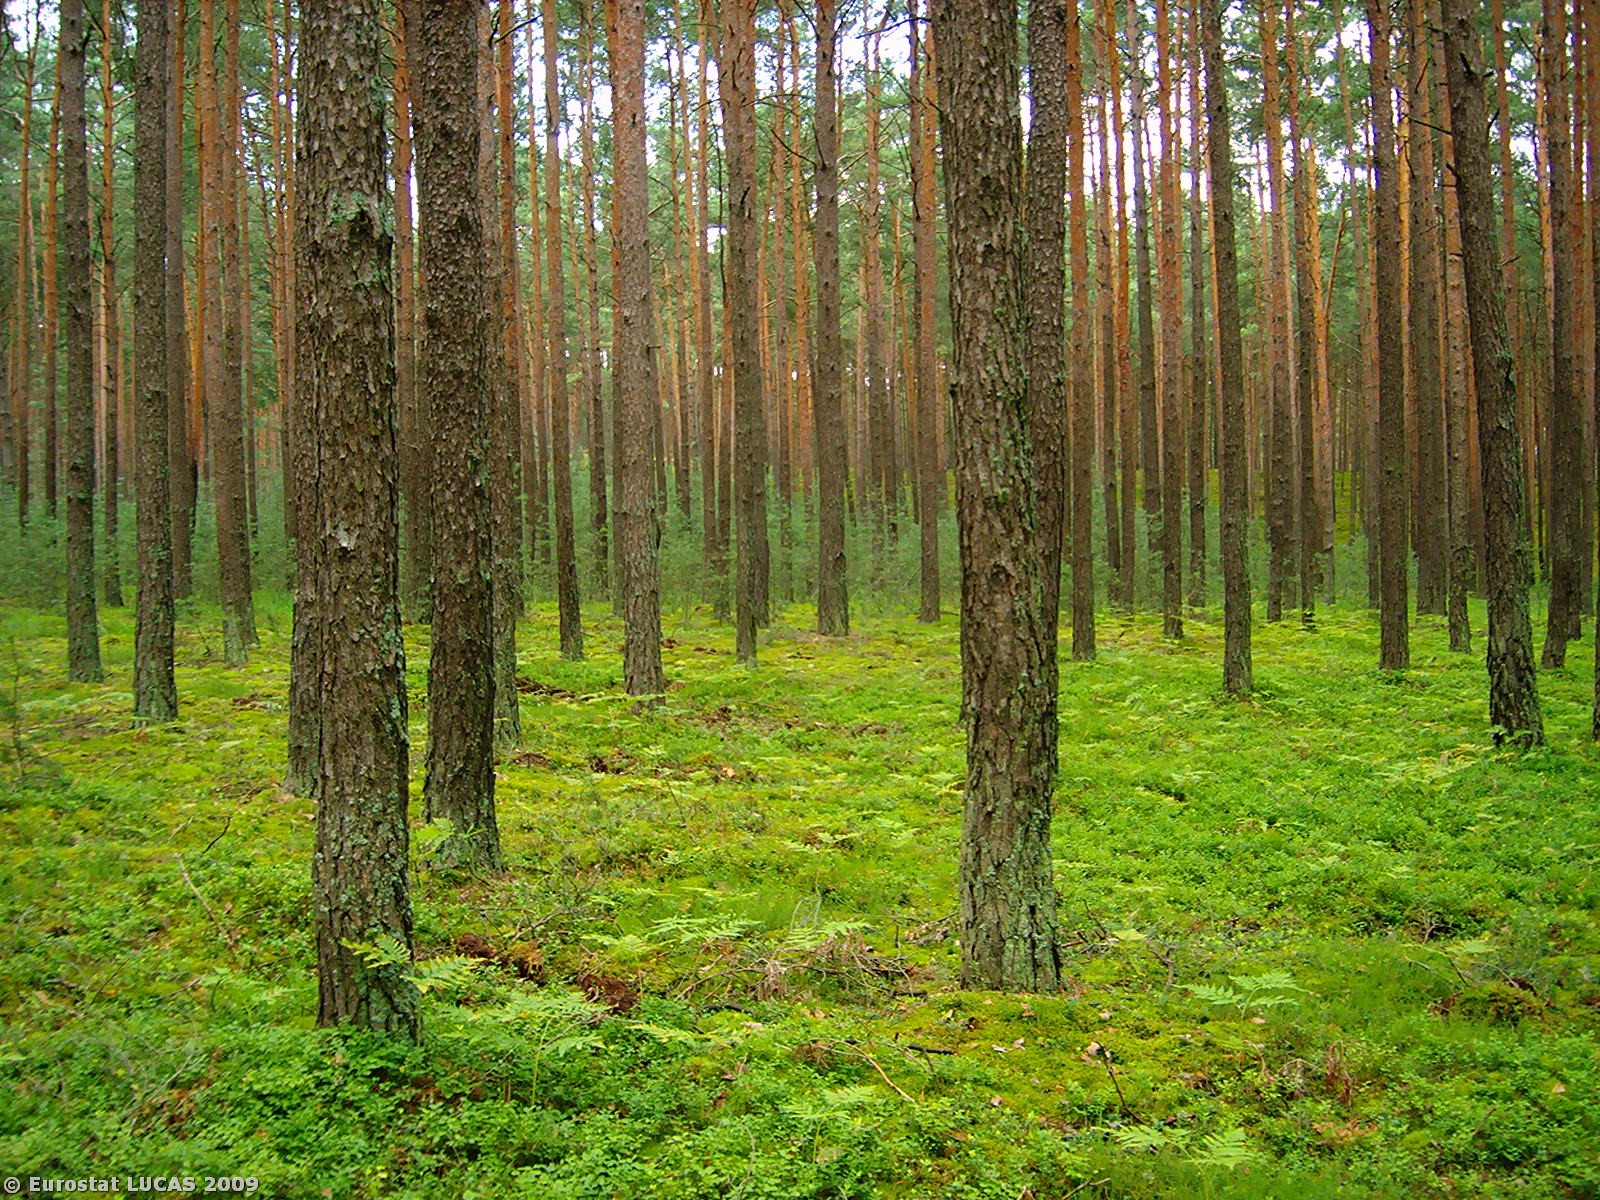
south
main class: Woodland
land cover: Coniferous woodland
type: hemiboreal forest and nemoral coniferous forest and mixed broadleaved-coniferous forest
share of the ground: 50 - 75 %
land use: Forestry
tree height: > 5 m
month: July
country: PL
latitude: 52.7183
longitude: 15.8823
